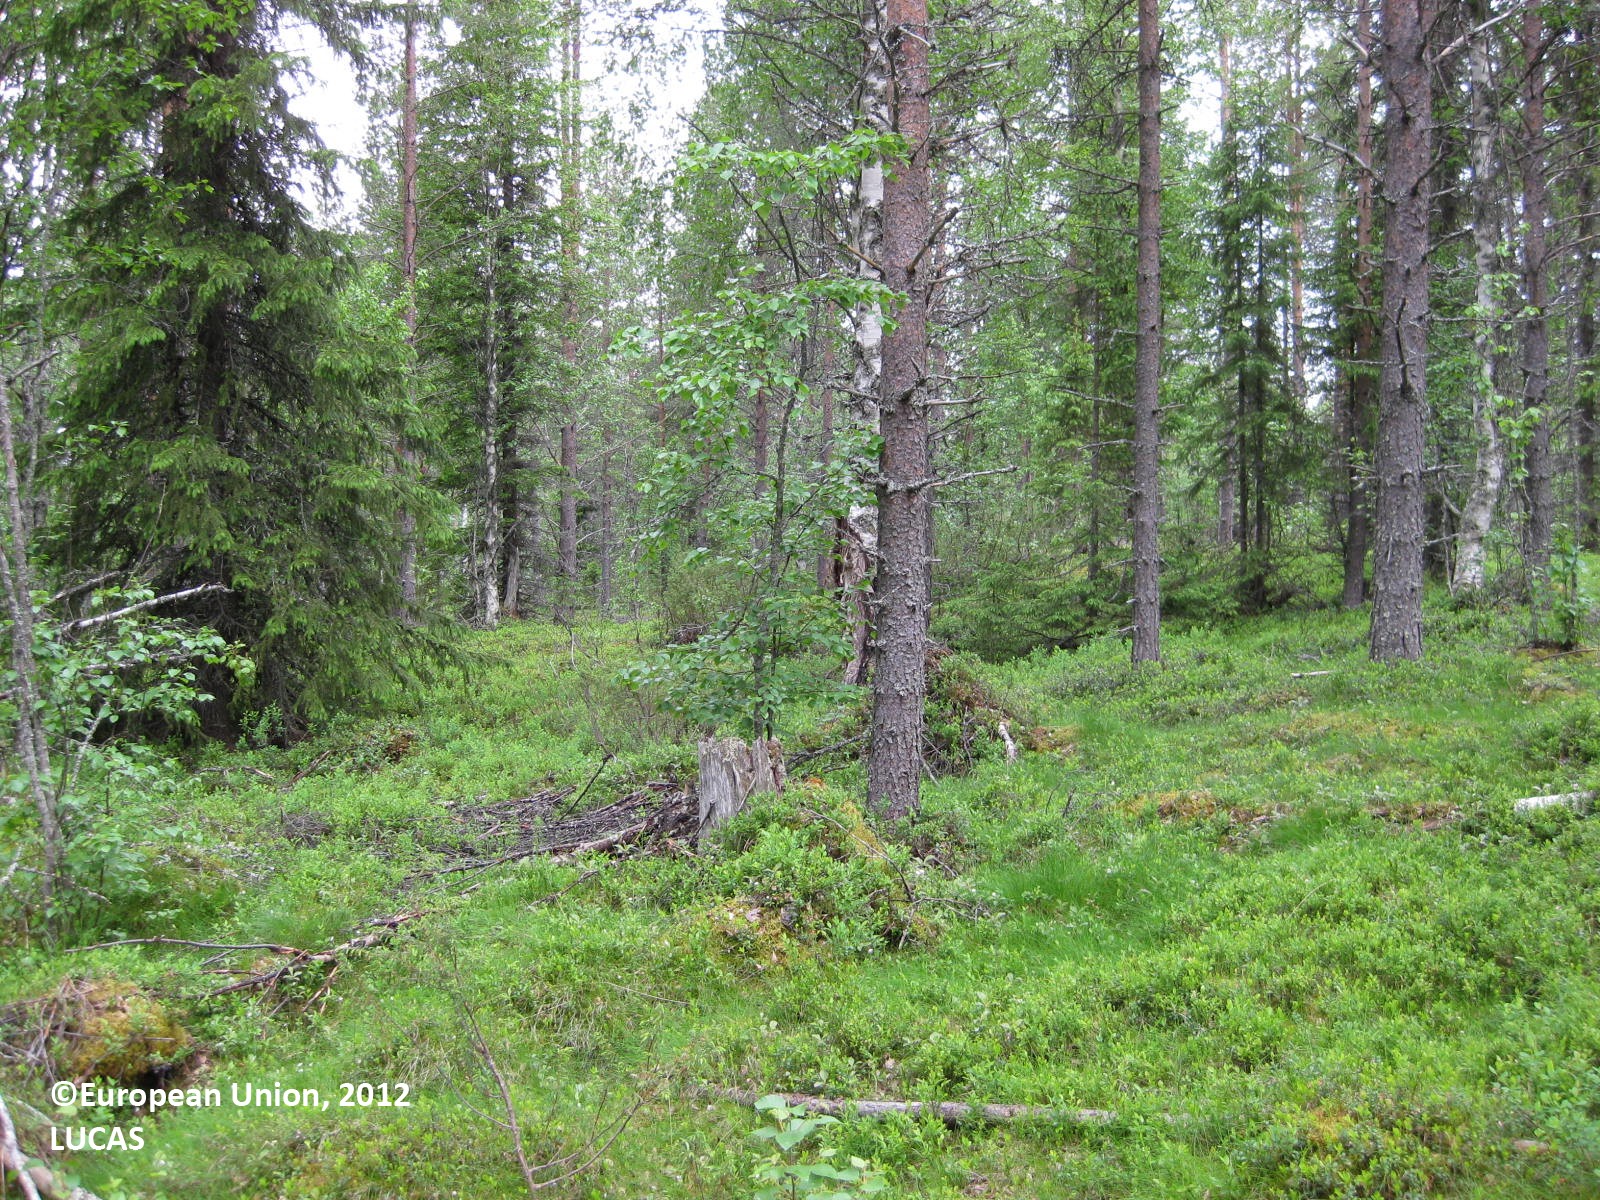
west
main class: Woodland
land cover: Other mixed woodland
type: boreal forest
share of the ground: > 75 %
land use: Forestry
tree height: > 5 m
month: June
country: FI
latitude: 65.1964
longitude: 28.2083
